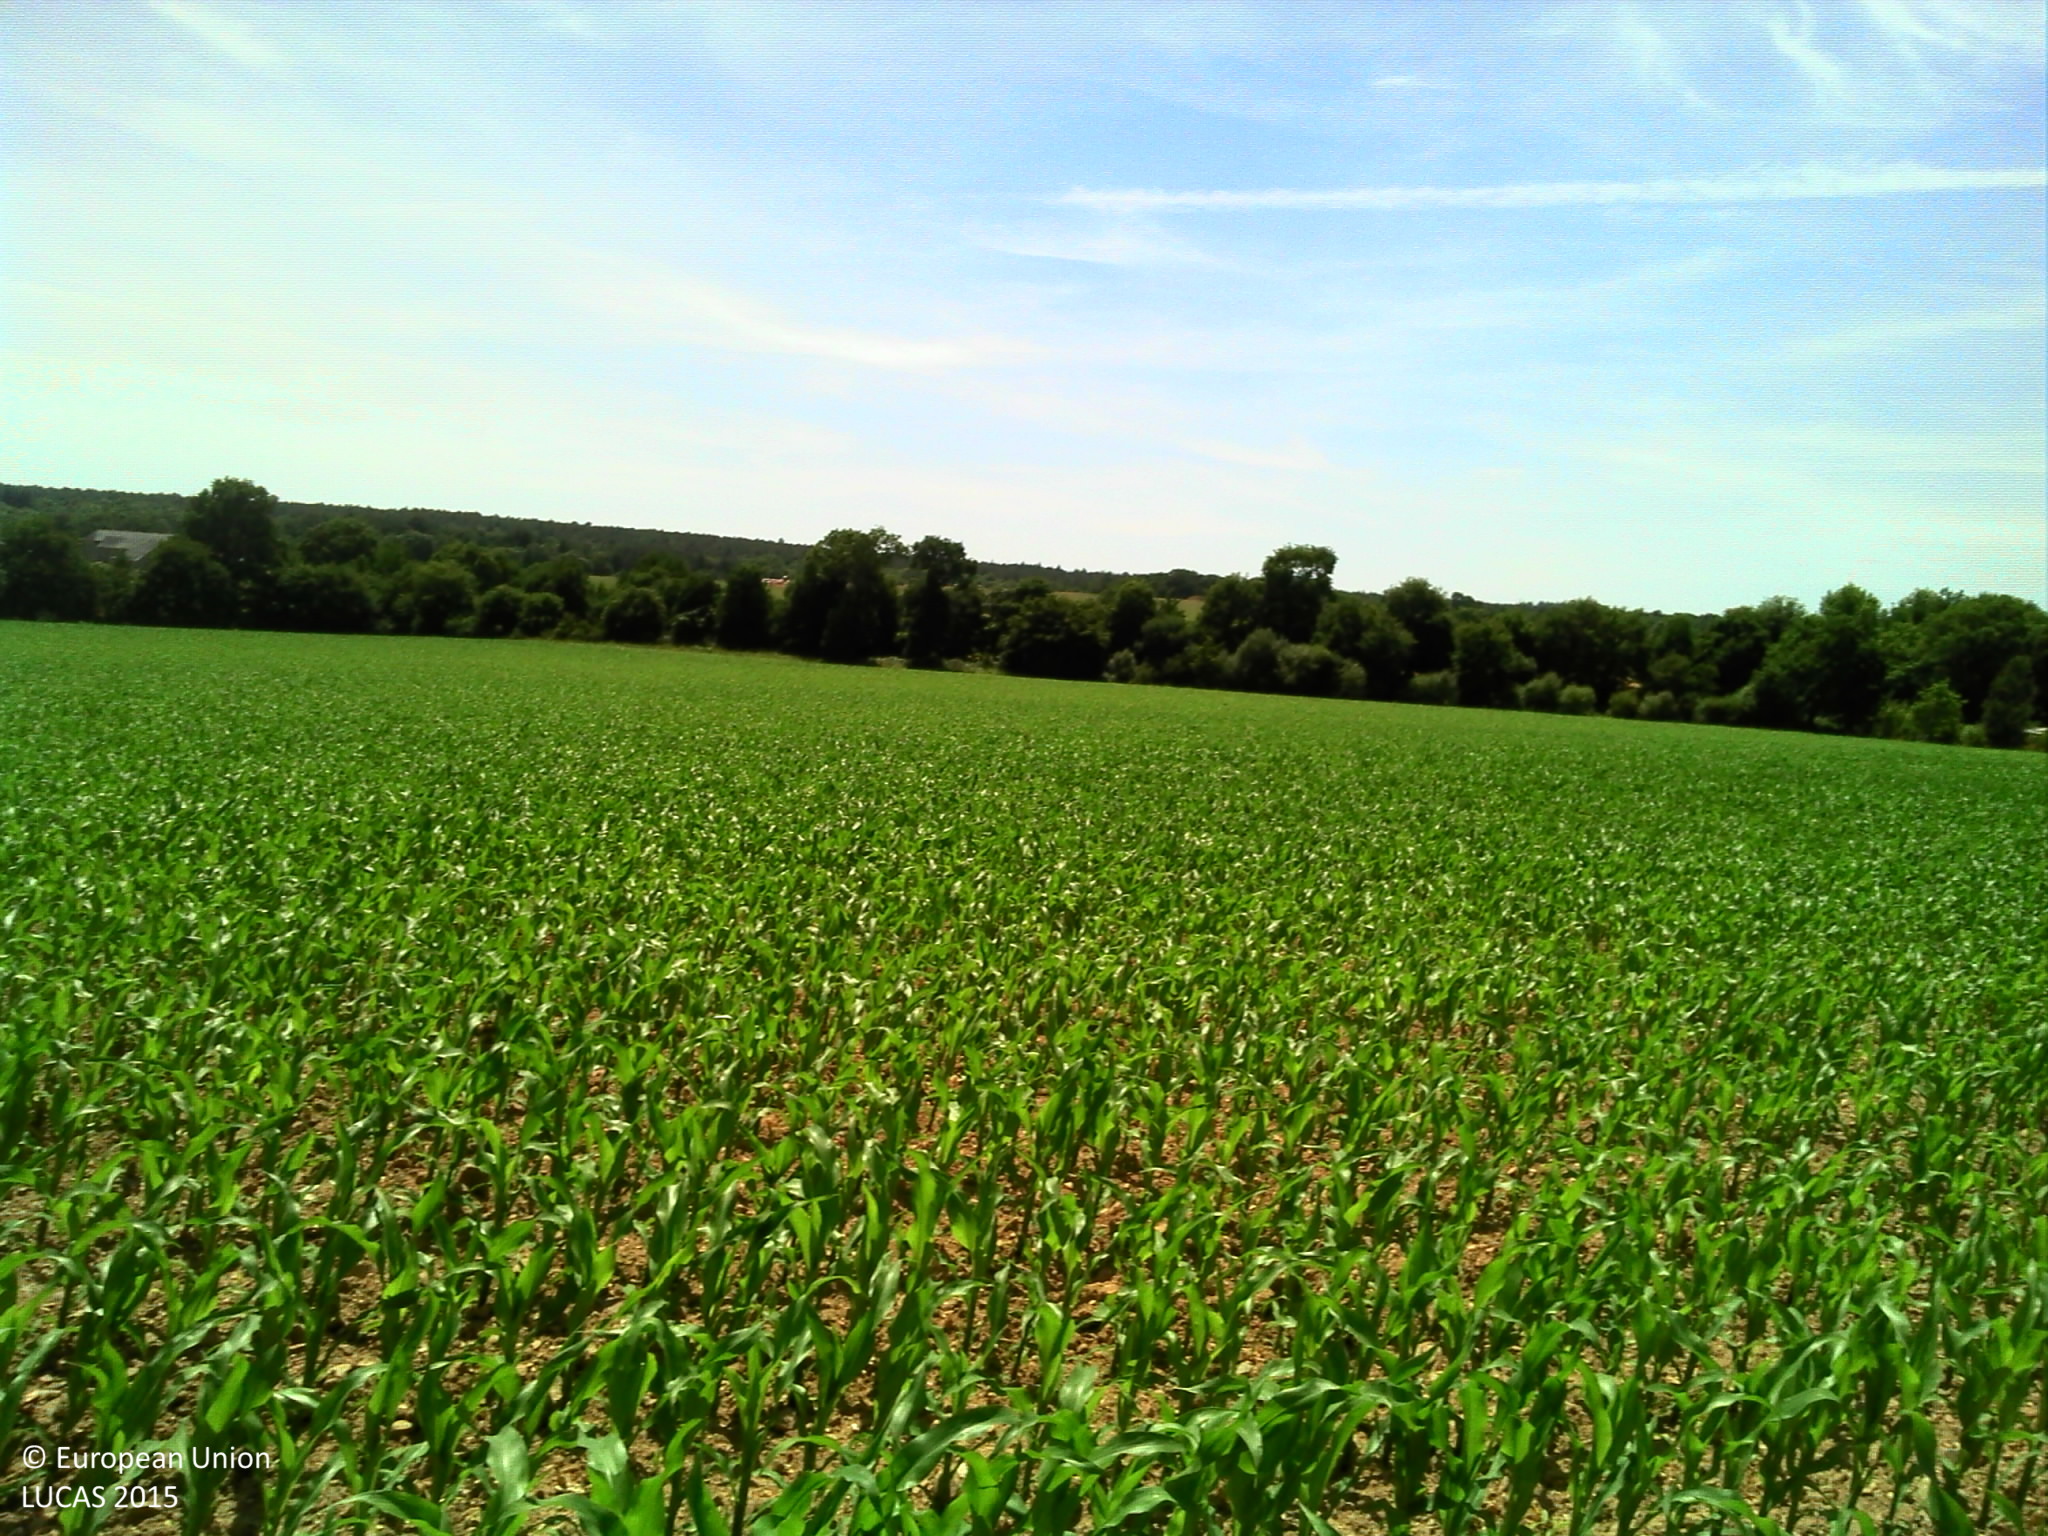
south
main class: Cropland
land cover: Maize
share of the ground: 50 - 75 %
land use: Agriculture (excluding fallow land and kitchen gardens)
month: June
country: FR
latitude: 48.0824
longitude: -2.0950
